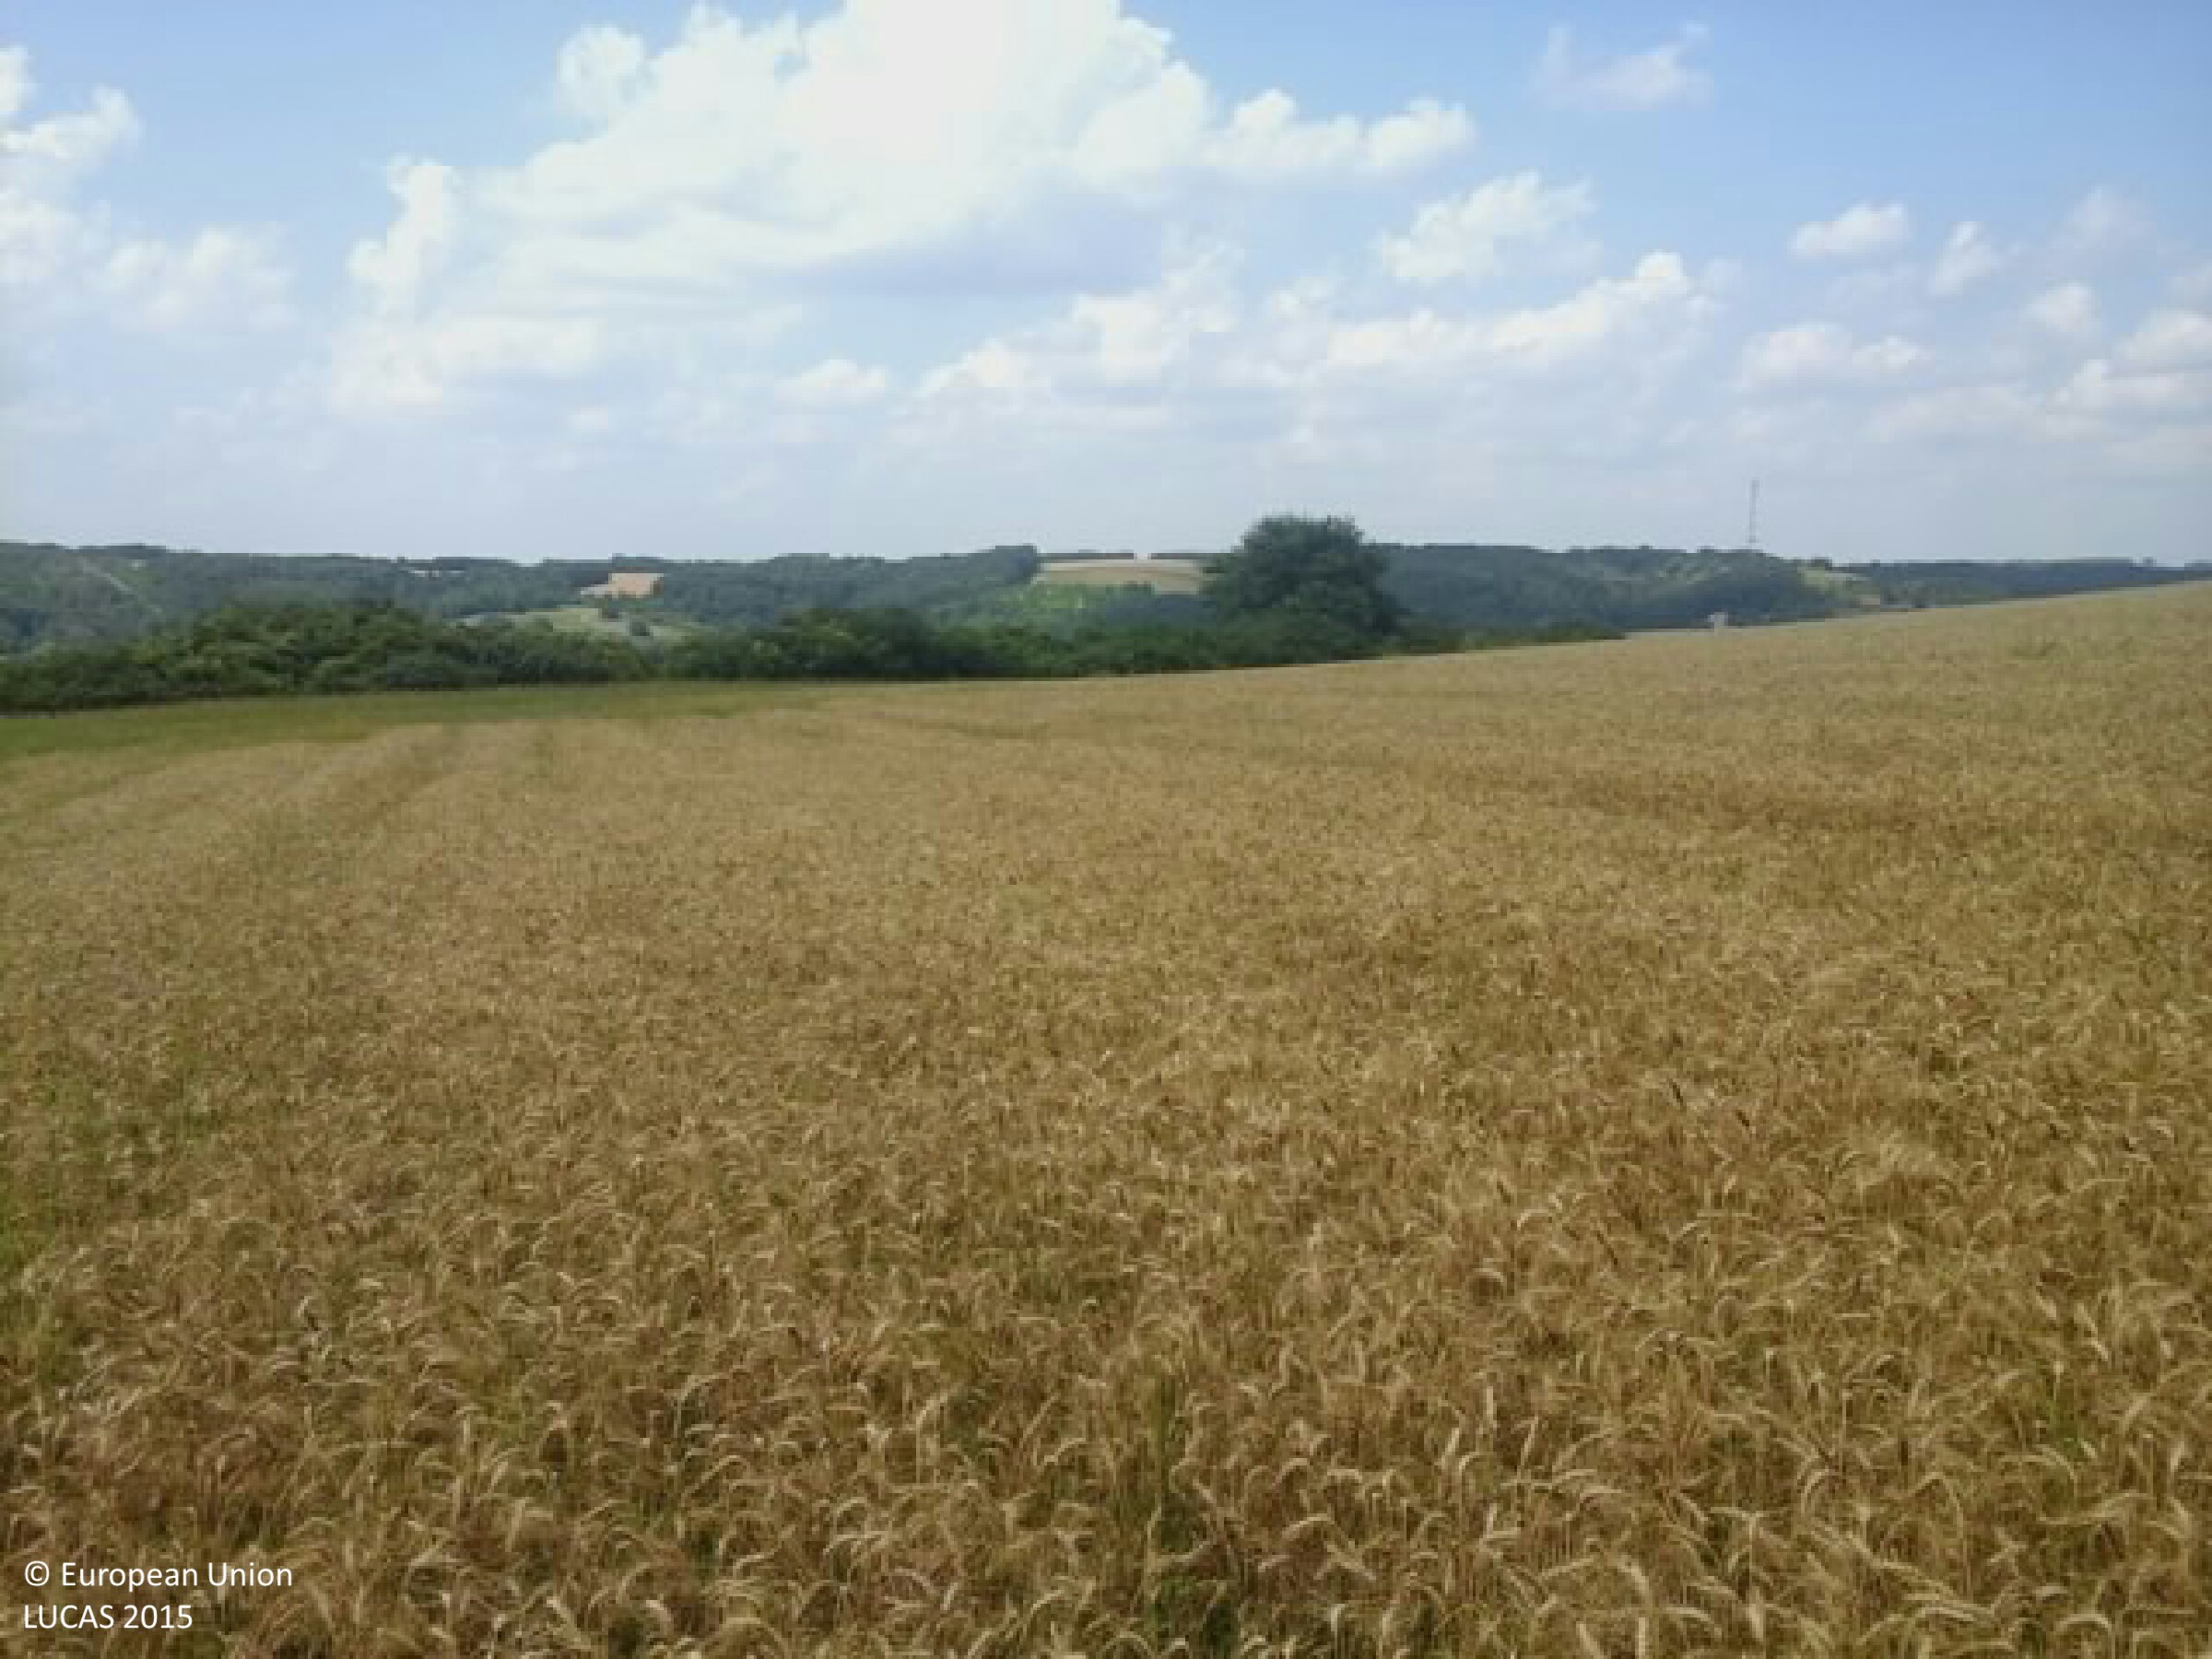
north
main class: Cropland
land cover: Triticale
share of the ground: > 75 %
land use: Agriculture (excluding fallow land and kitchen gardens)
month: August
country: HU
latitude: 46.2001
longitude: 18.1846
